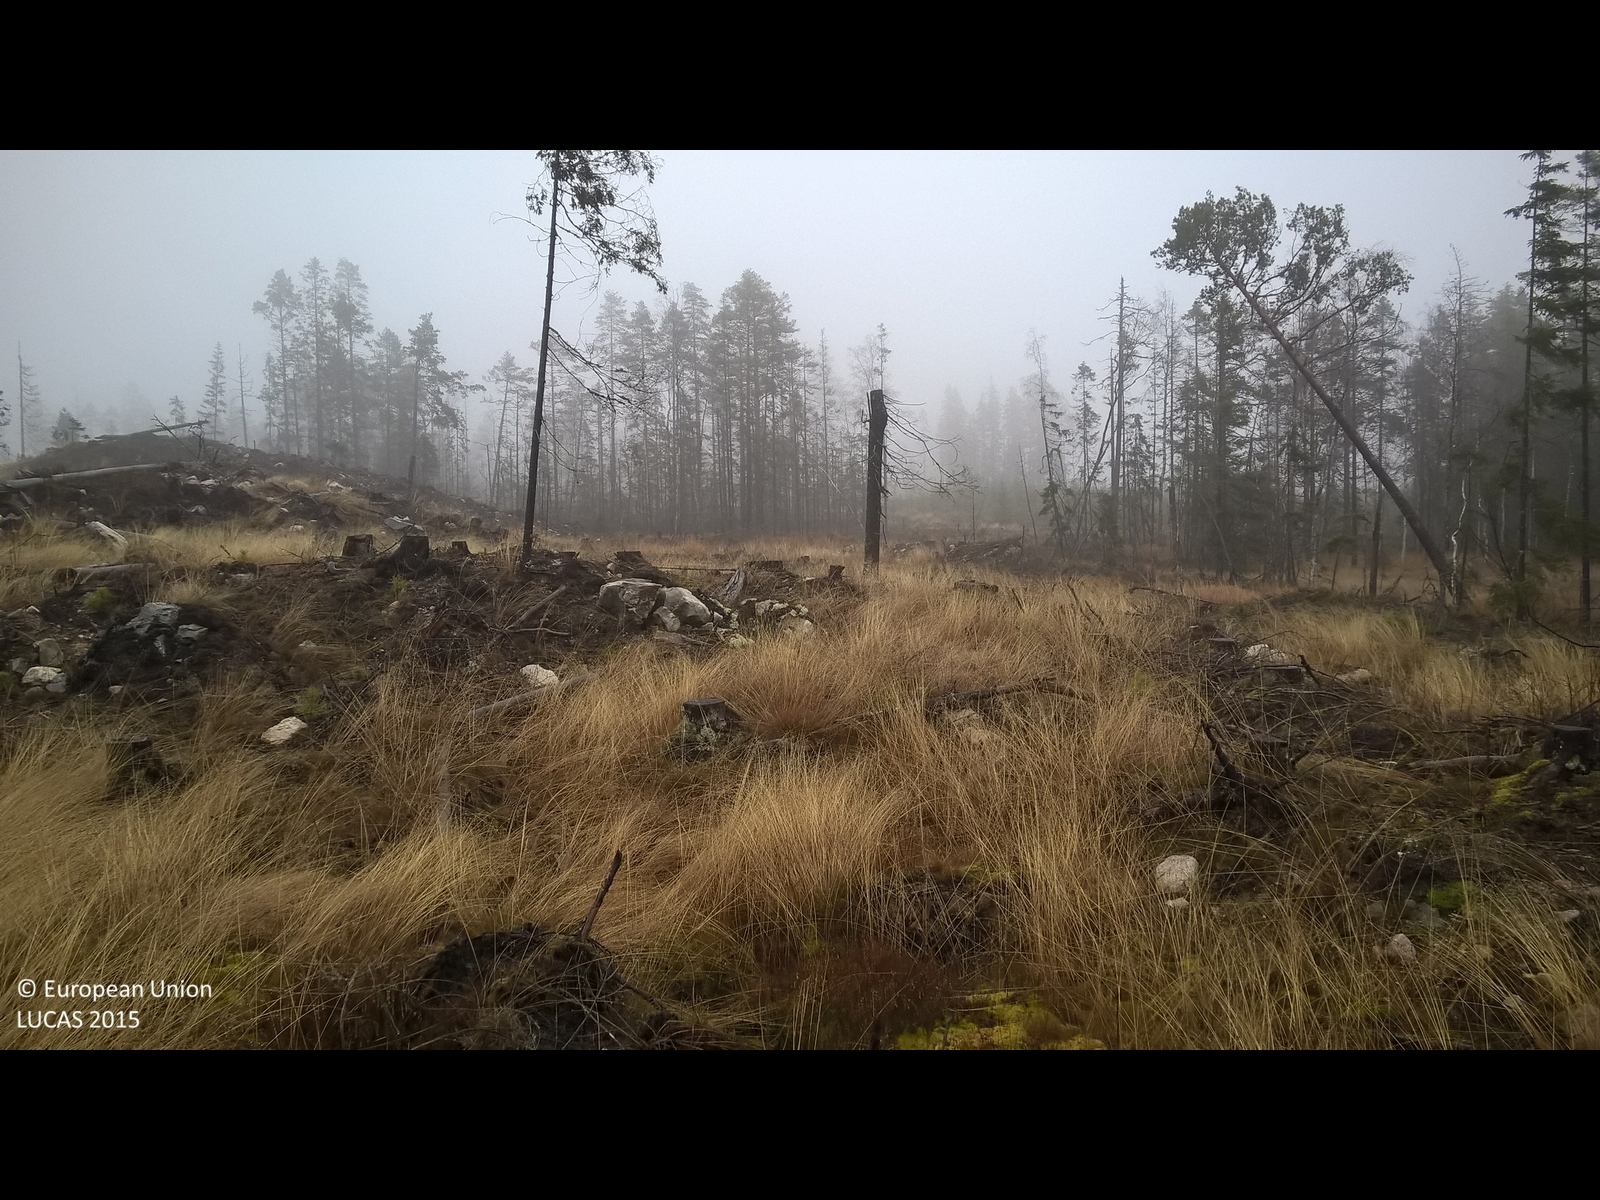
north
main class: Grassland
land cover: Grassland with sparse tree/shrub cover
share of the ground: > 75 %
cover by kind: herbaceous plants 75 %, shrubs 10 %, lichens and mosses 10 %, coniferous forest trees 5 %
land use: Forestry
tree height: > 5 m
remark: Clear cut
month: November
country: SE
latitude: 60.0634
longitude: 14.7858
